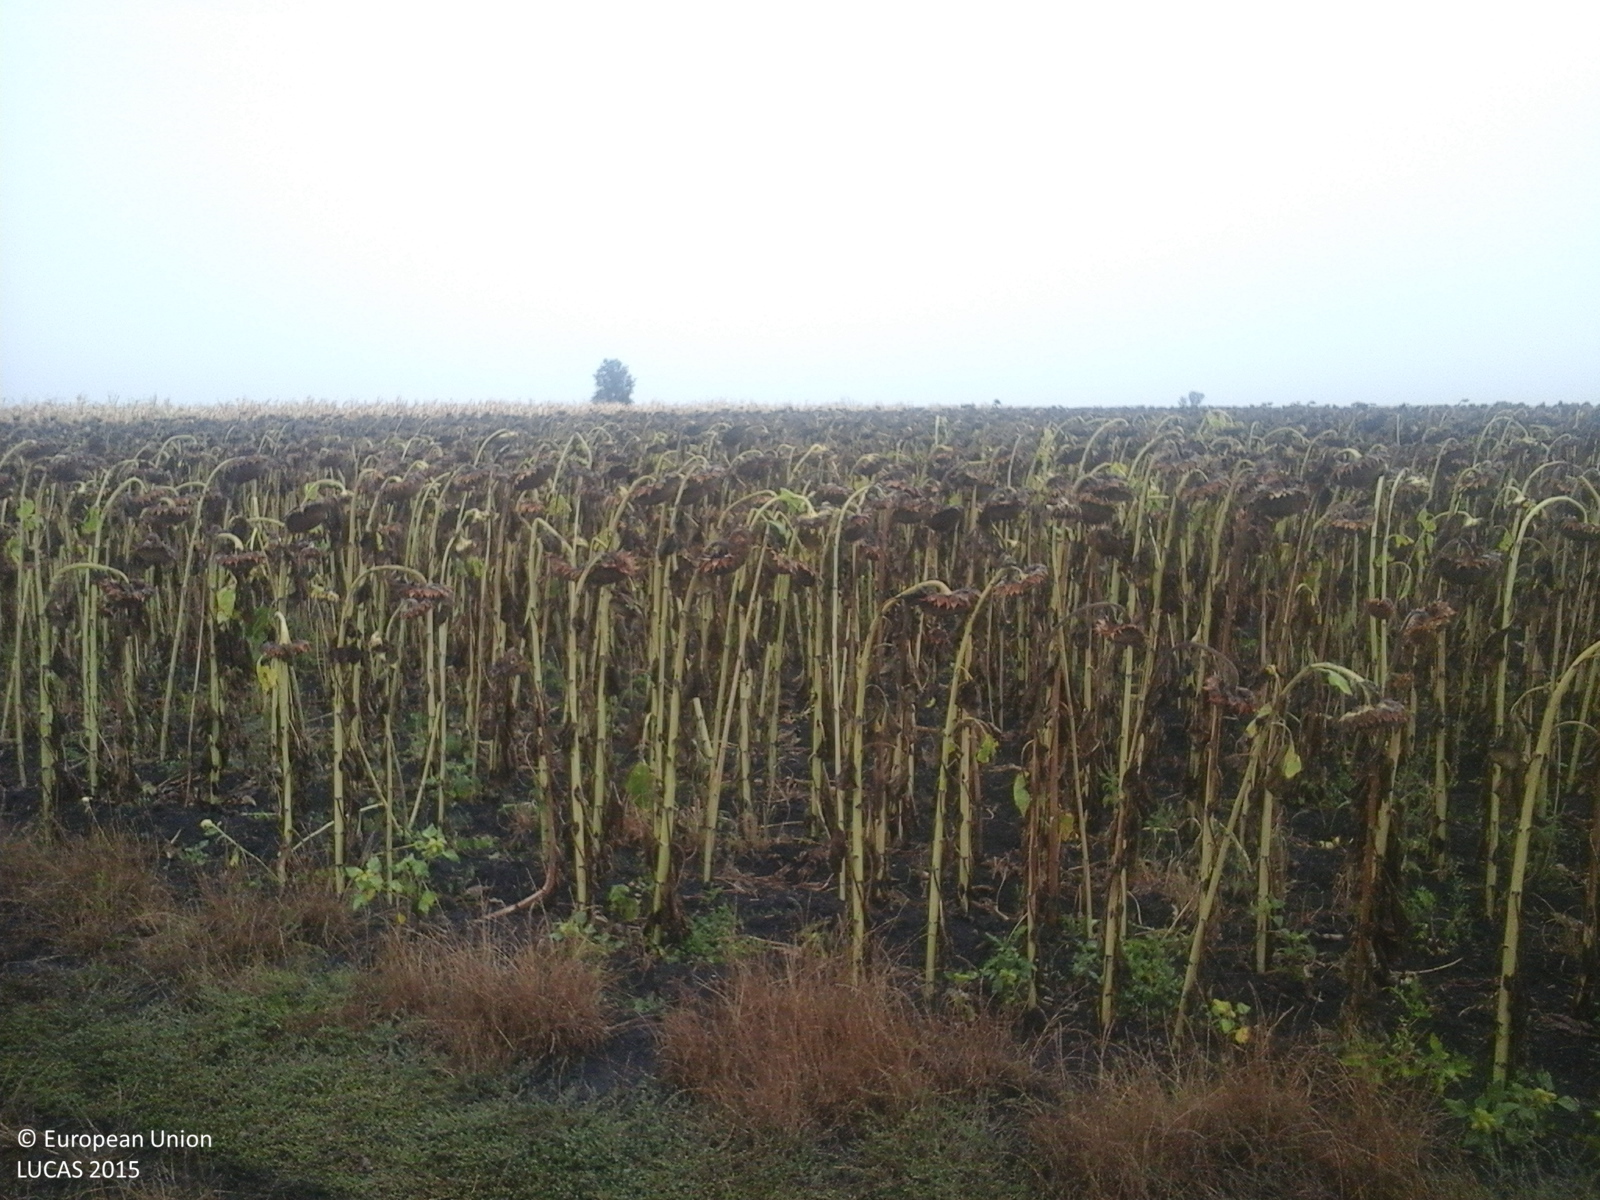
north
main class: Cropland
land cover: Sunflower
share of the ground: > 75 %
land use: Agriculture (excluding fallow land and kitchen gardens)
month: September
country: RO
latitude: 47.7392
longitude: 22.5547
